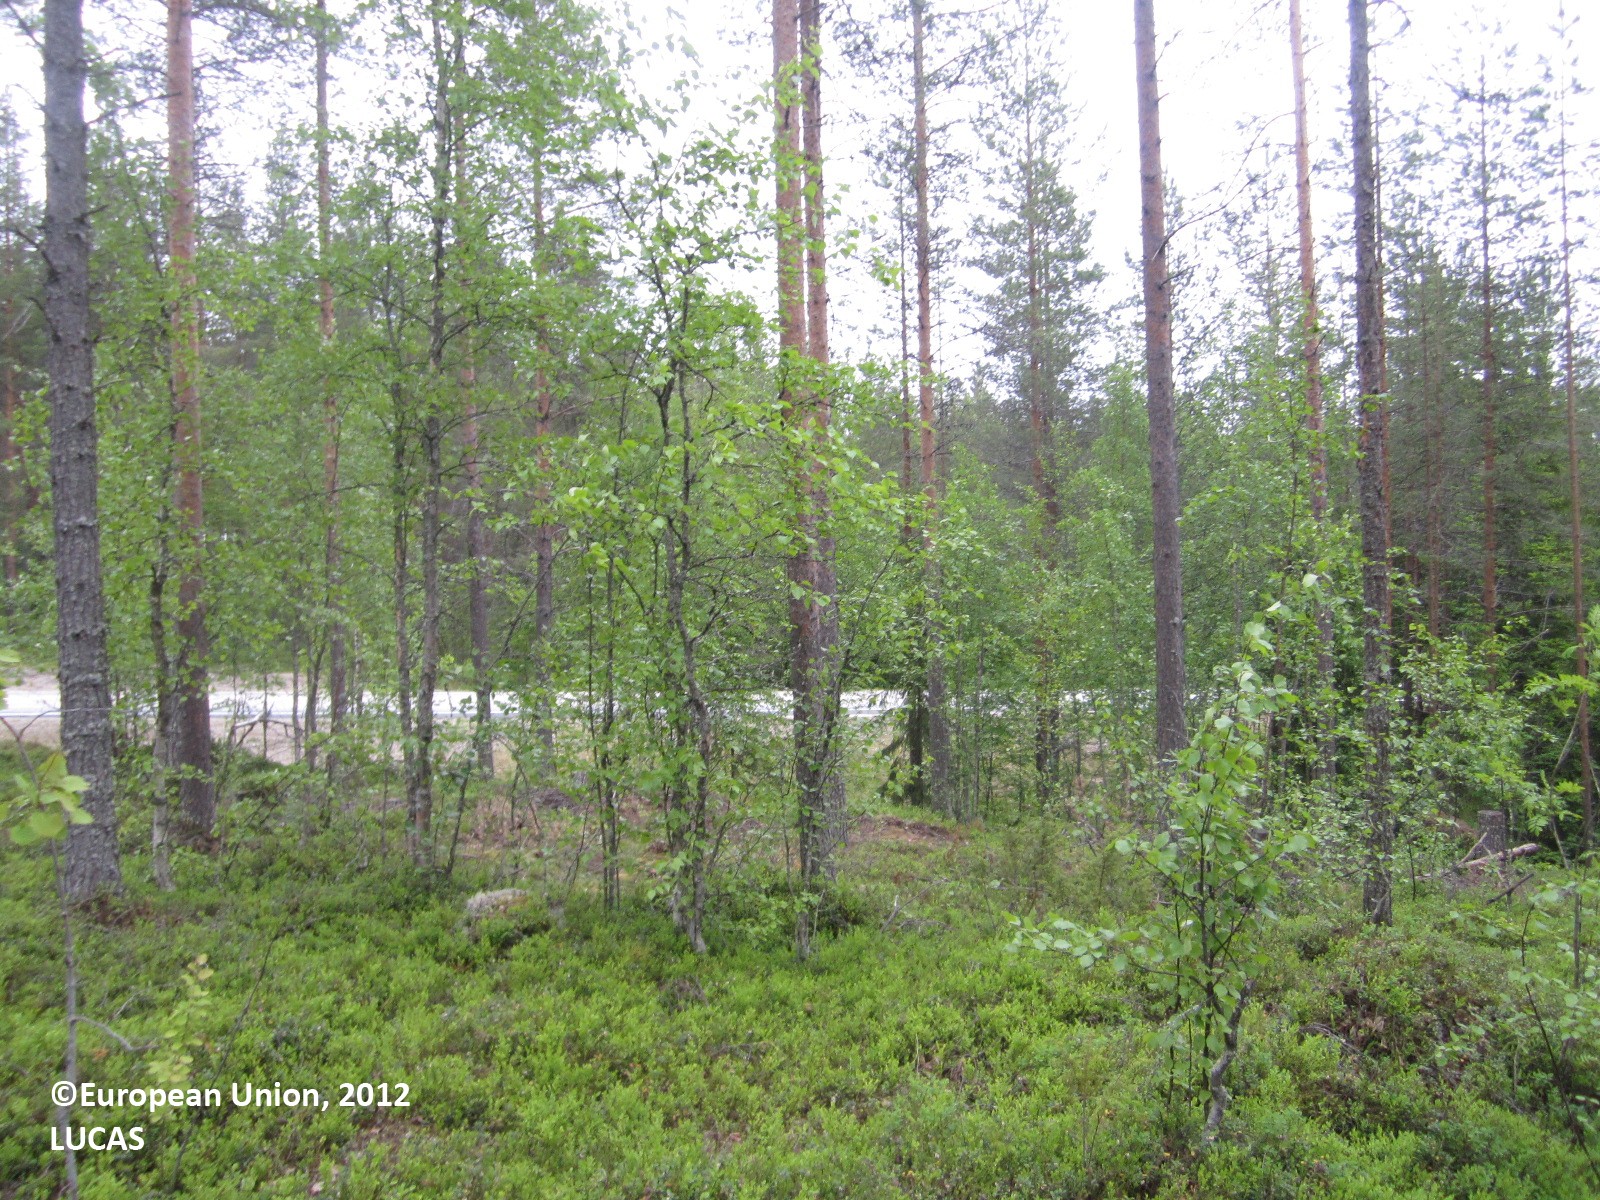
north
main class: Woodland
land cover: Pine dominated coniferous woodland
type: boreal forest
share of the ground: 50 - 75 %
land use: Forestry
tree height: > 5 m
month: June
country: FI
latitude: 64.4580
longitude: 29.5258
